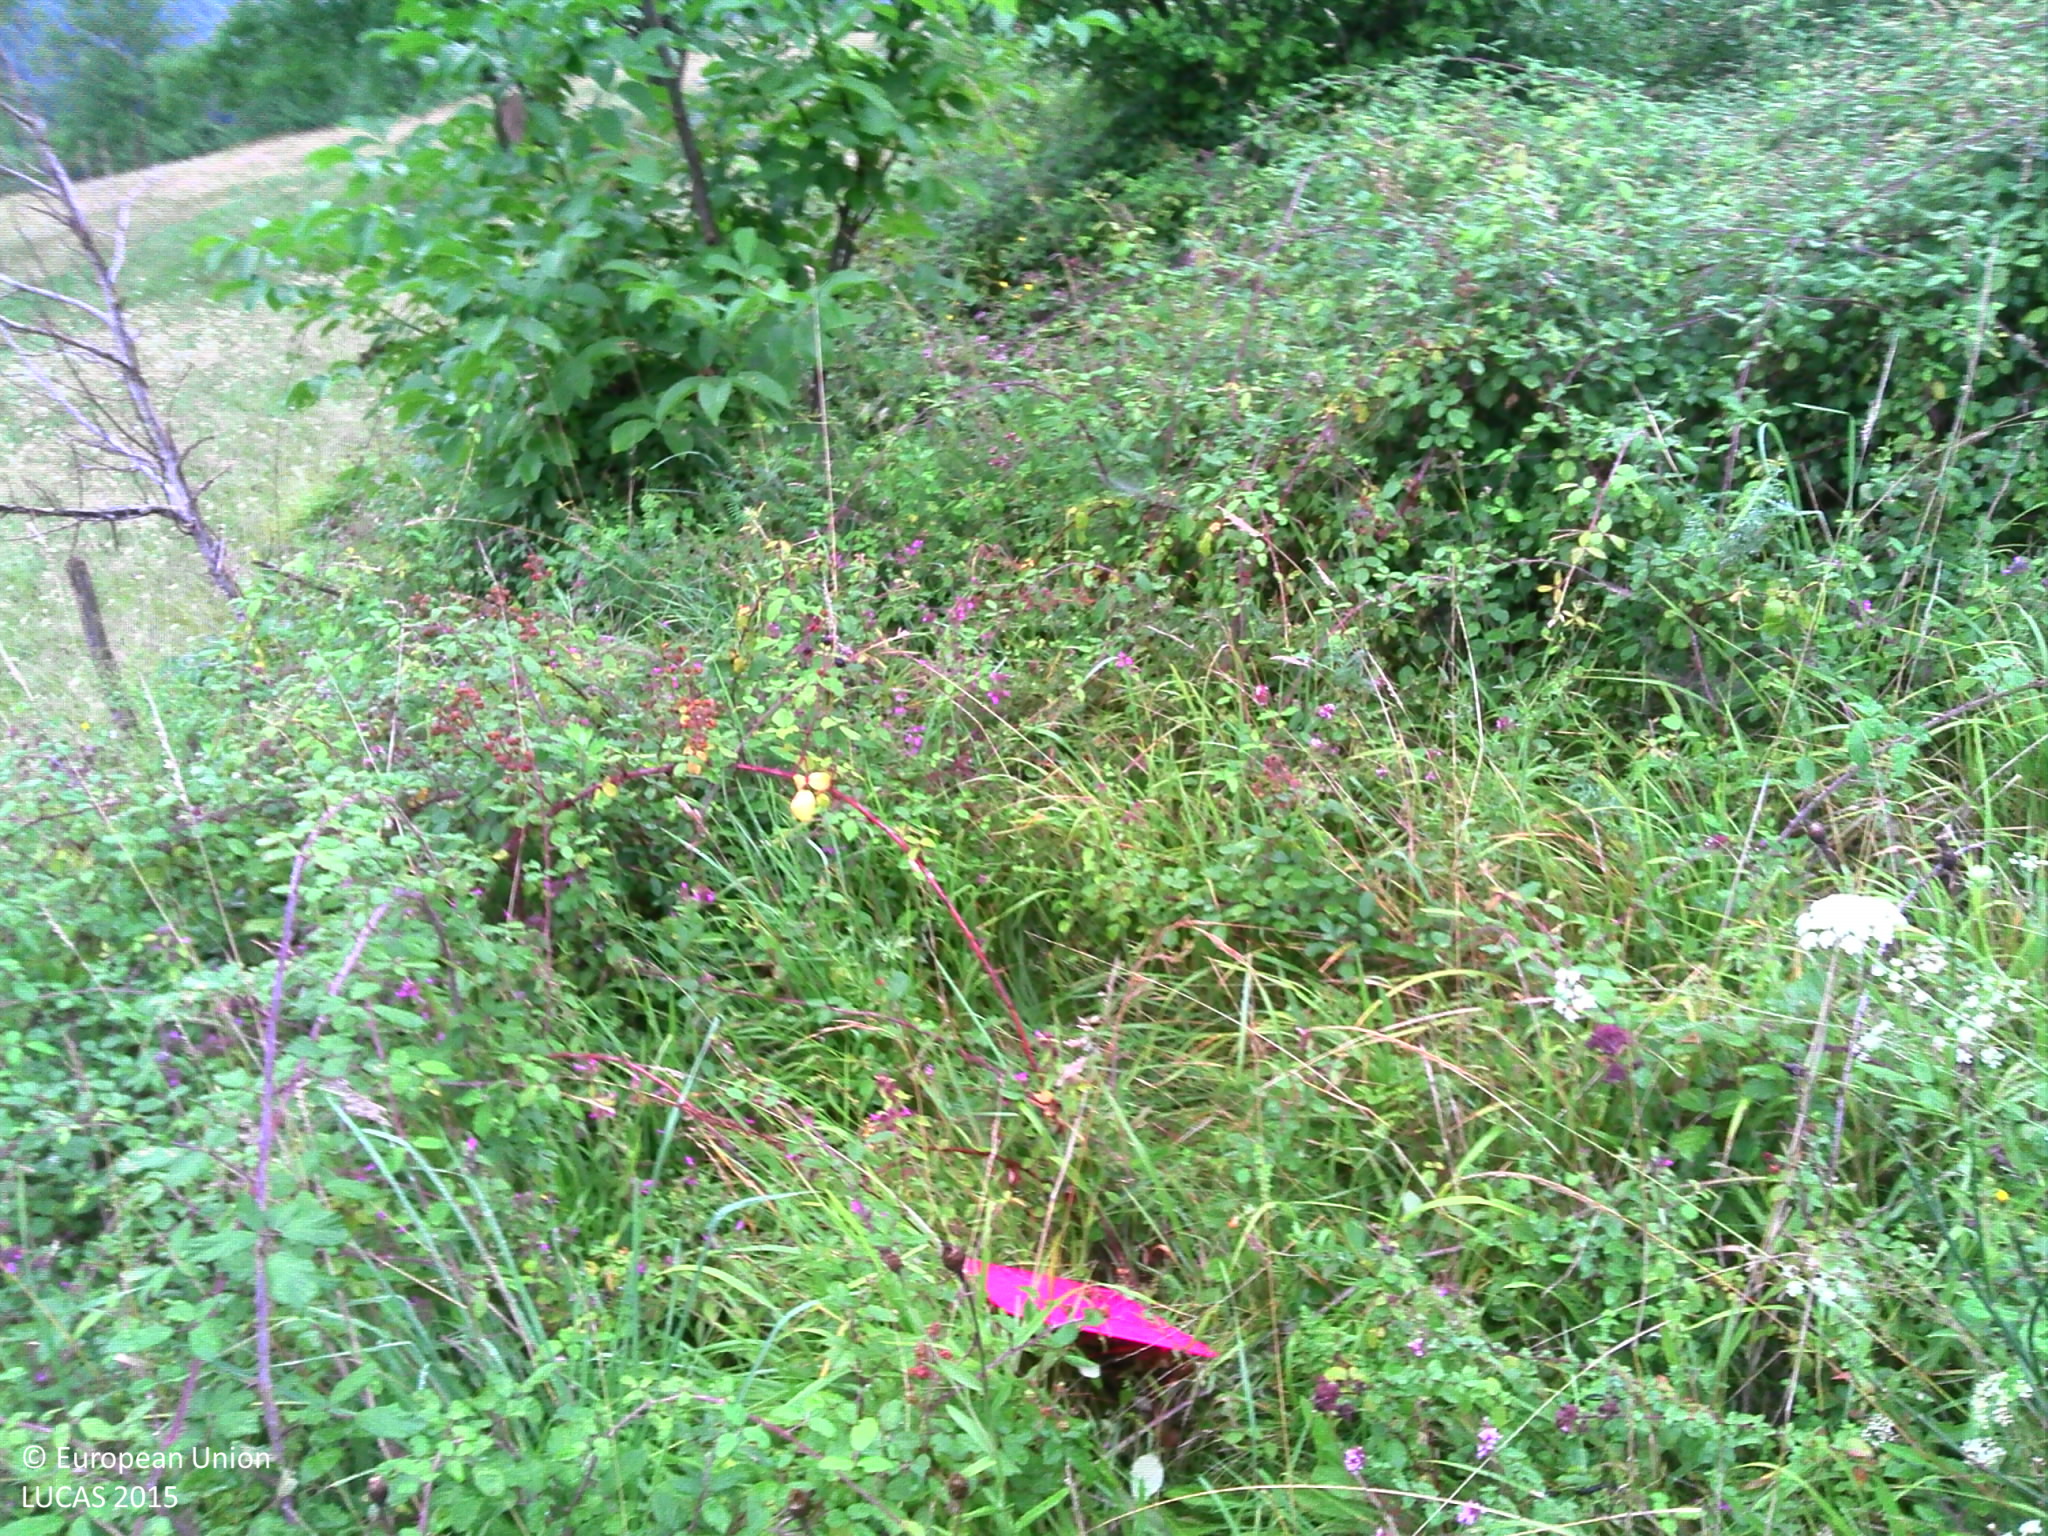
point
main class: Grassland
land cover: Spontaneously vegetated surfaces
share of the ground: > 75 %
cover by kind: herbaceous plants 100 %
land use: Semi-natural and natural areas not in use
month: August
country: FR
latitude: 42.8929
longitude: 1.0535
